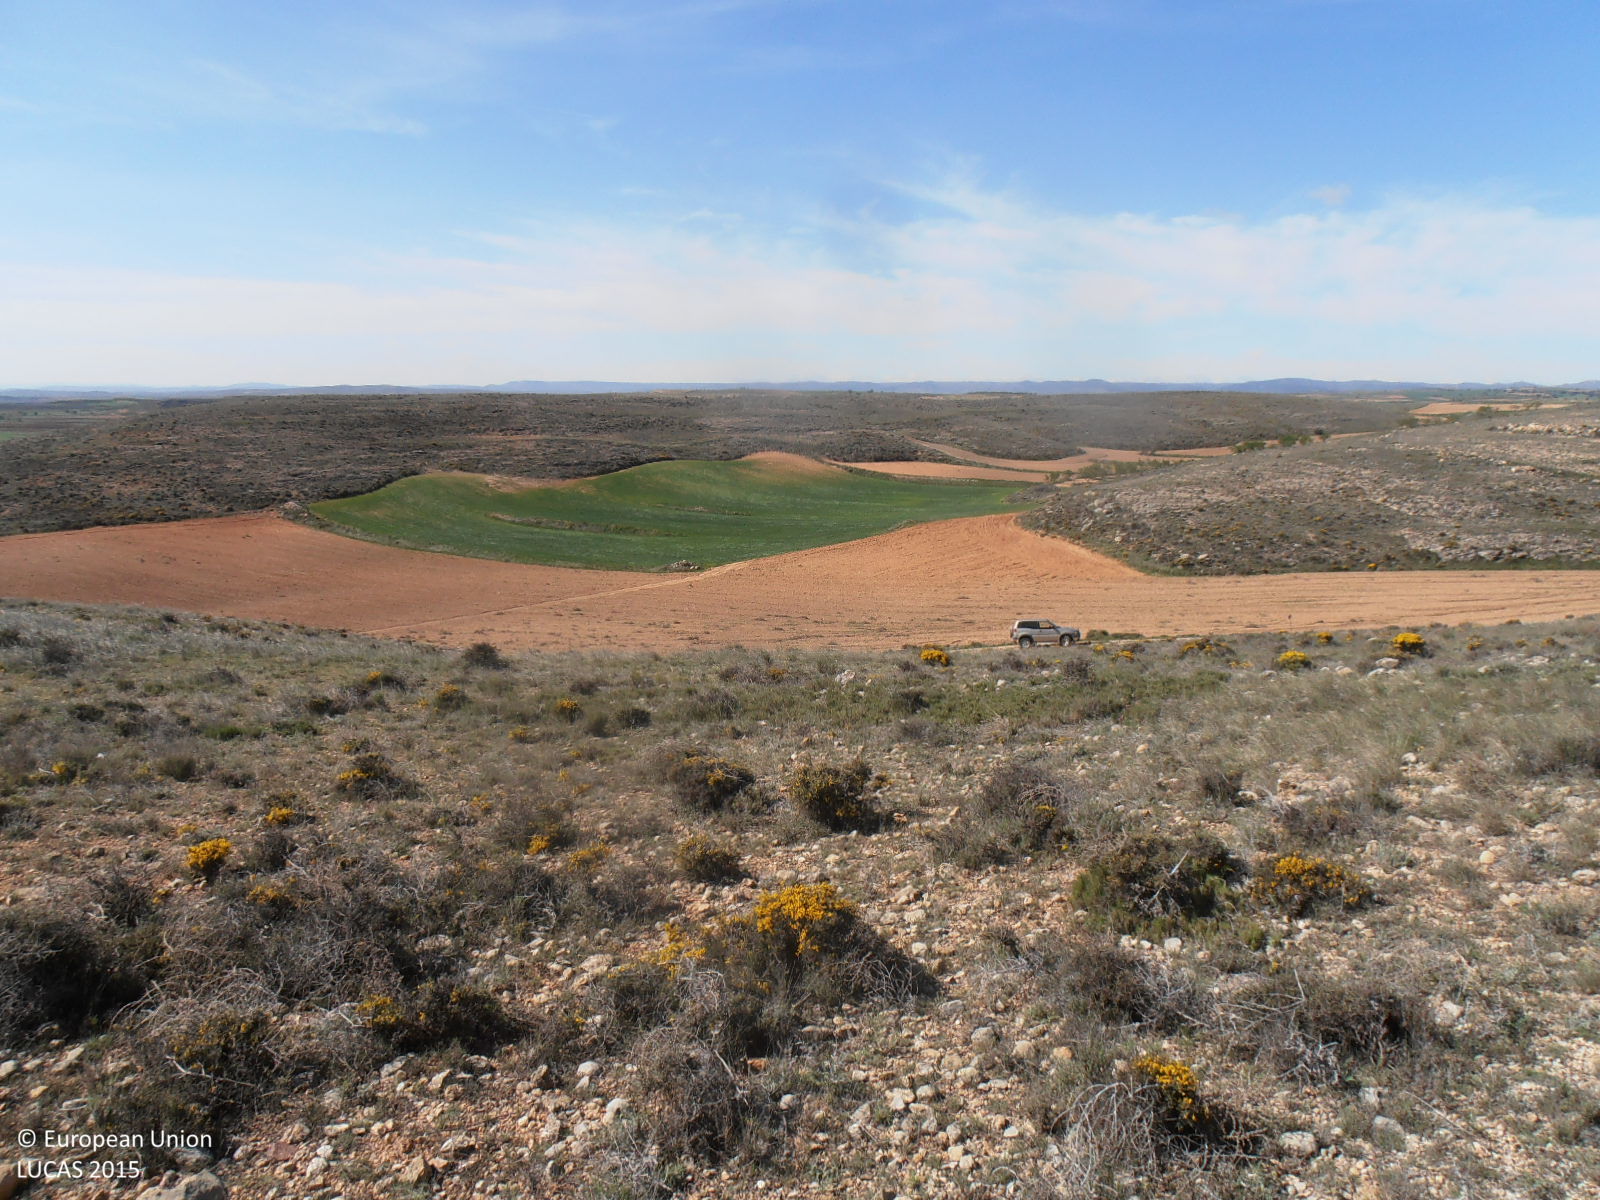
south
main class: Shrubland
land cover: Shrubland without tree cover
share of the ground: 50 - 75 %
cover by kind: consolidated bare surface 50 %, shrubs 40 %, herbaceous plants 10 %
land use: Semi-natural and natural areas not in use
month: April
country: ES
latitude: 41.1663
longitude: -0.9470
